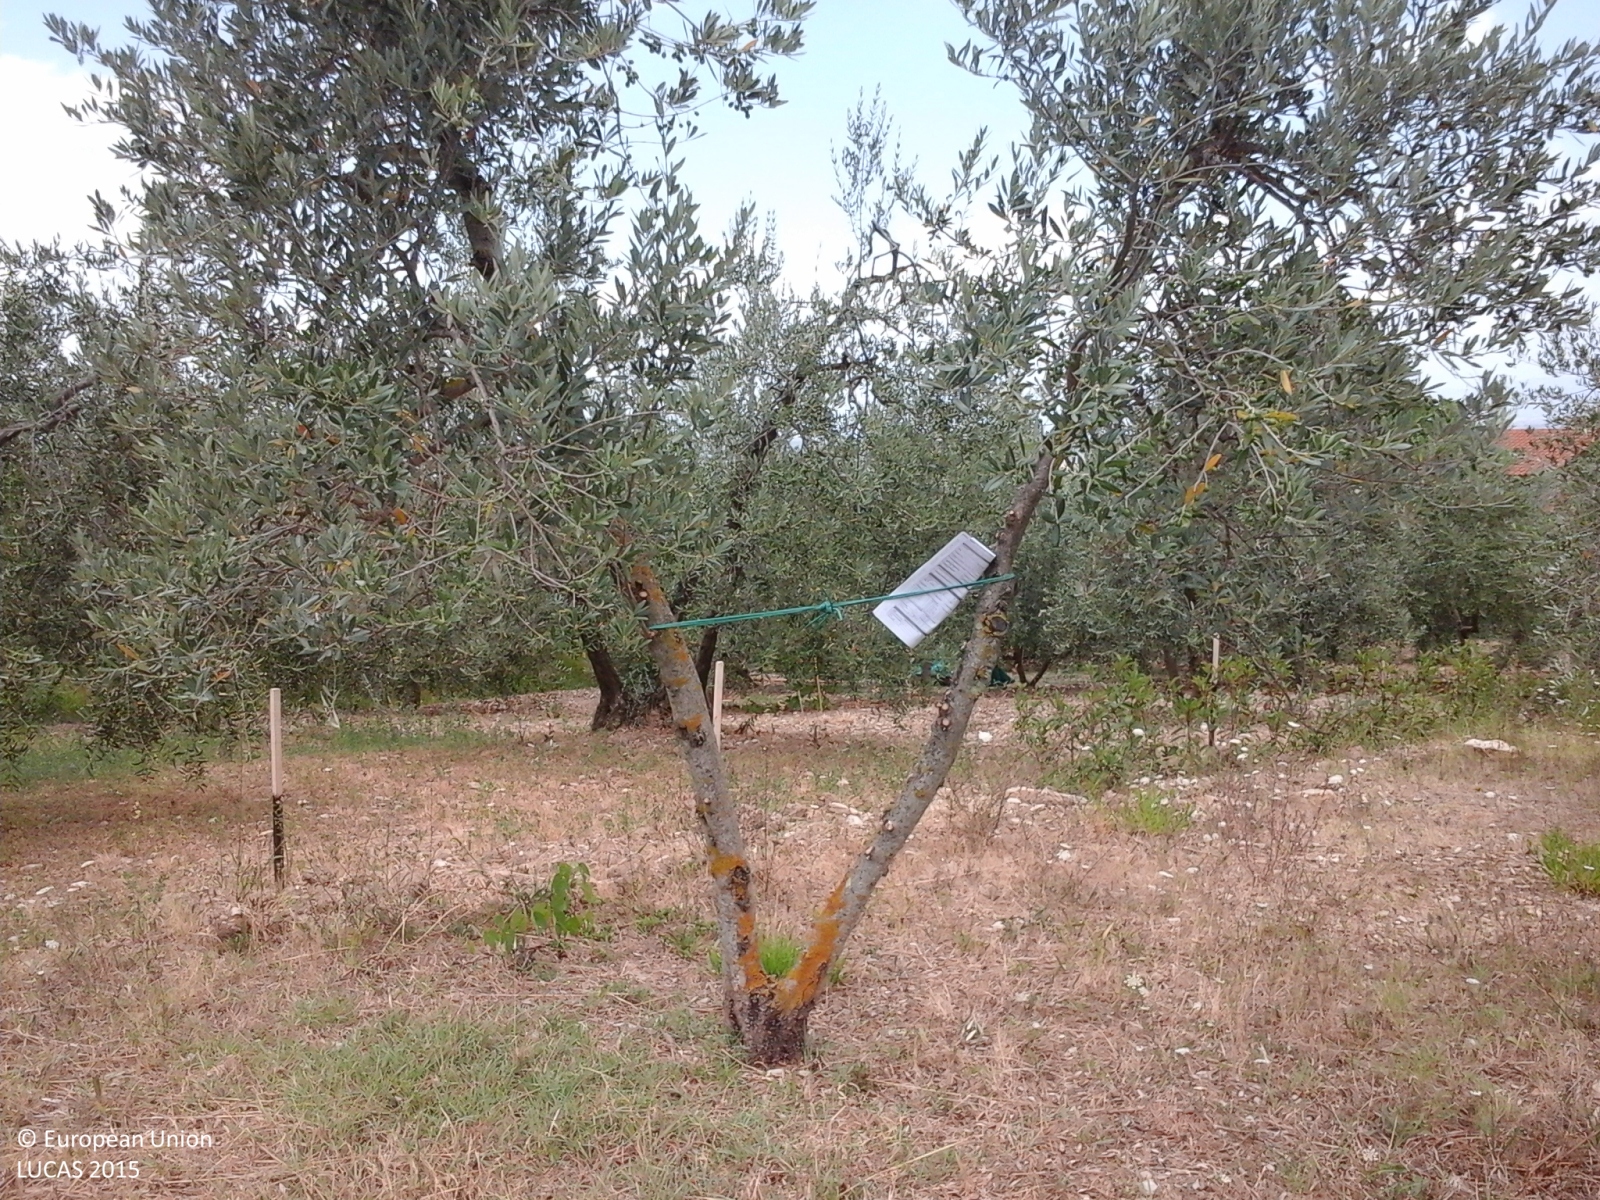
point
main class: Cropland
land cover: Olive groves
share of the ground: > 75 %
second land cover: Spontaneously vegetated surfaces
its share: > 75 %
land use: Agriculture (excluding fallow land and kitchen gardens)
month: July
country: IT
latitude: 43.5343
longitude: 10.9502
